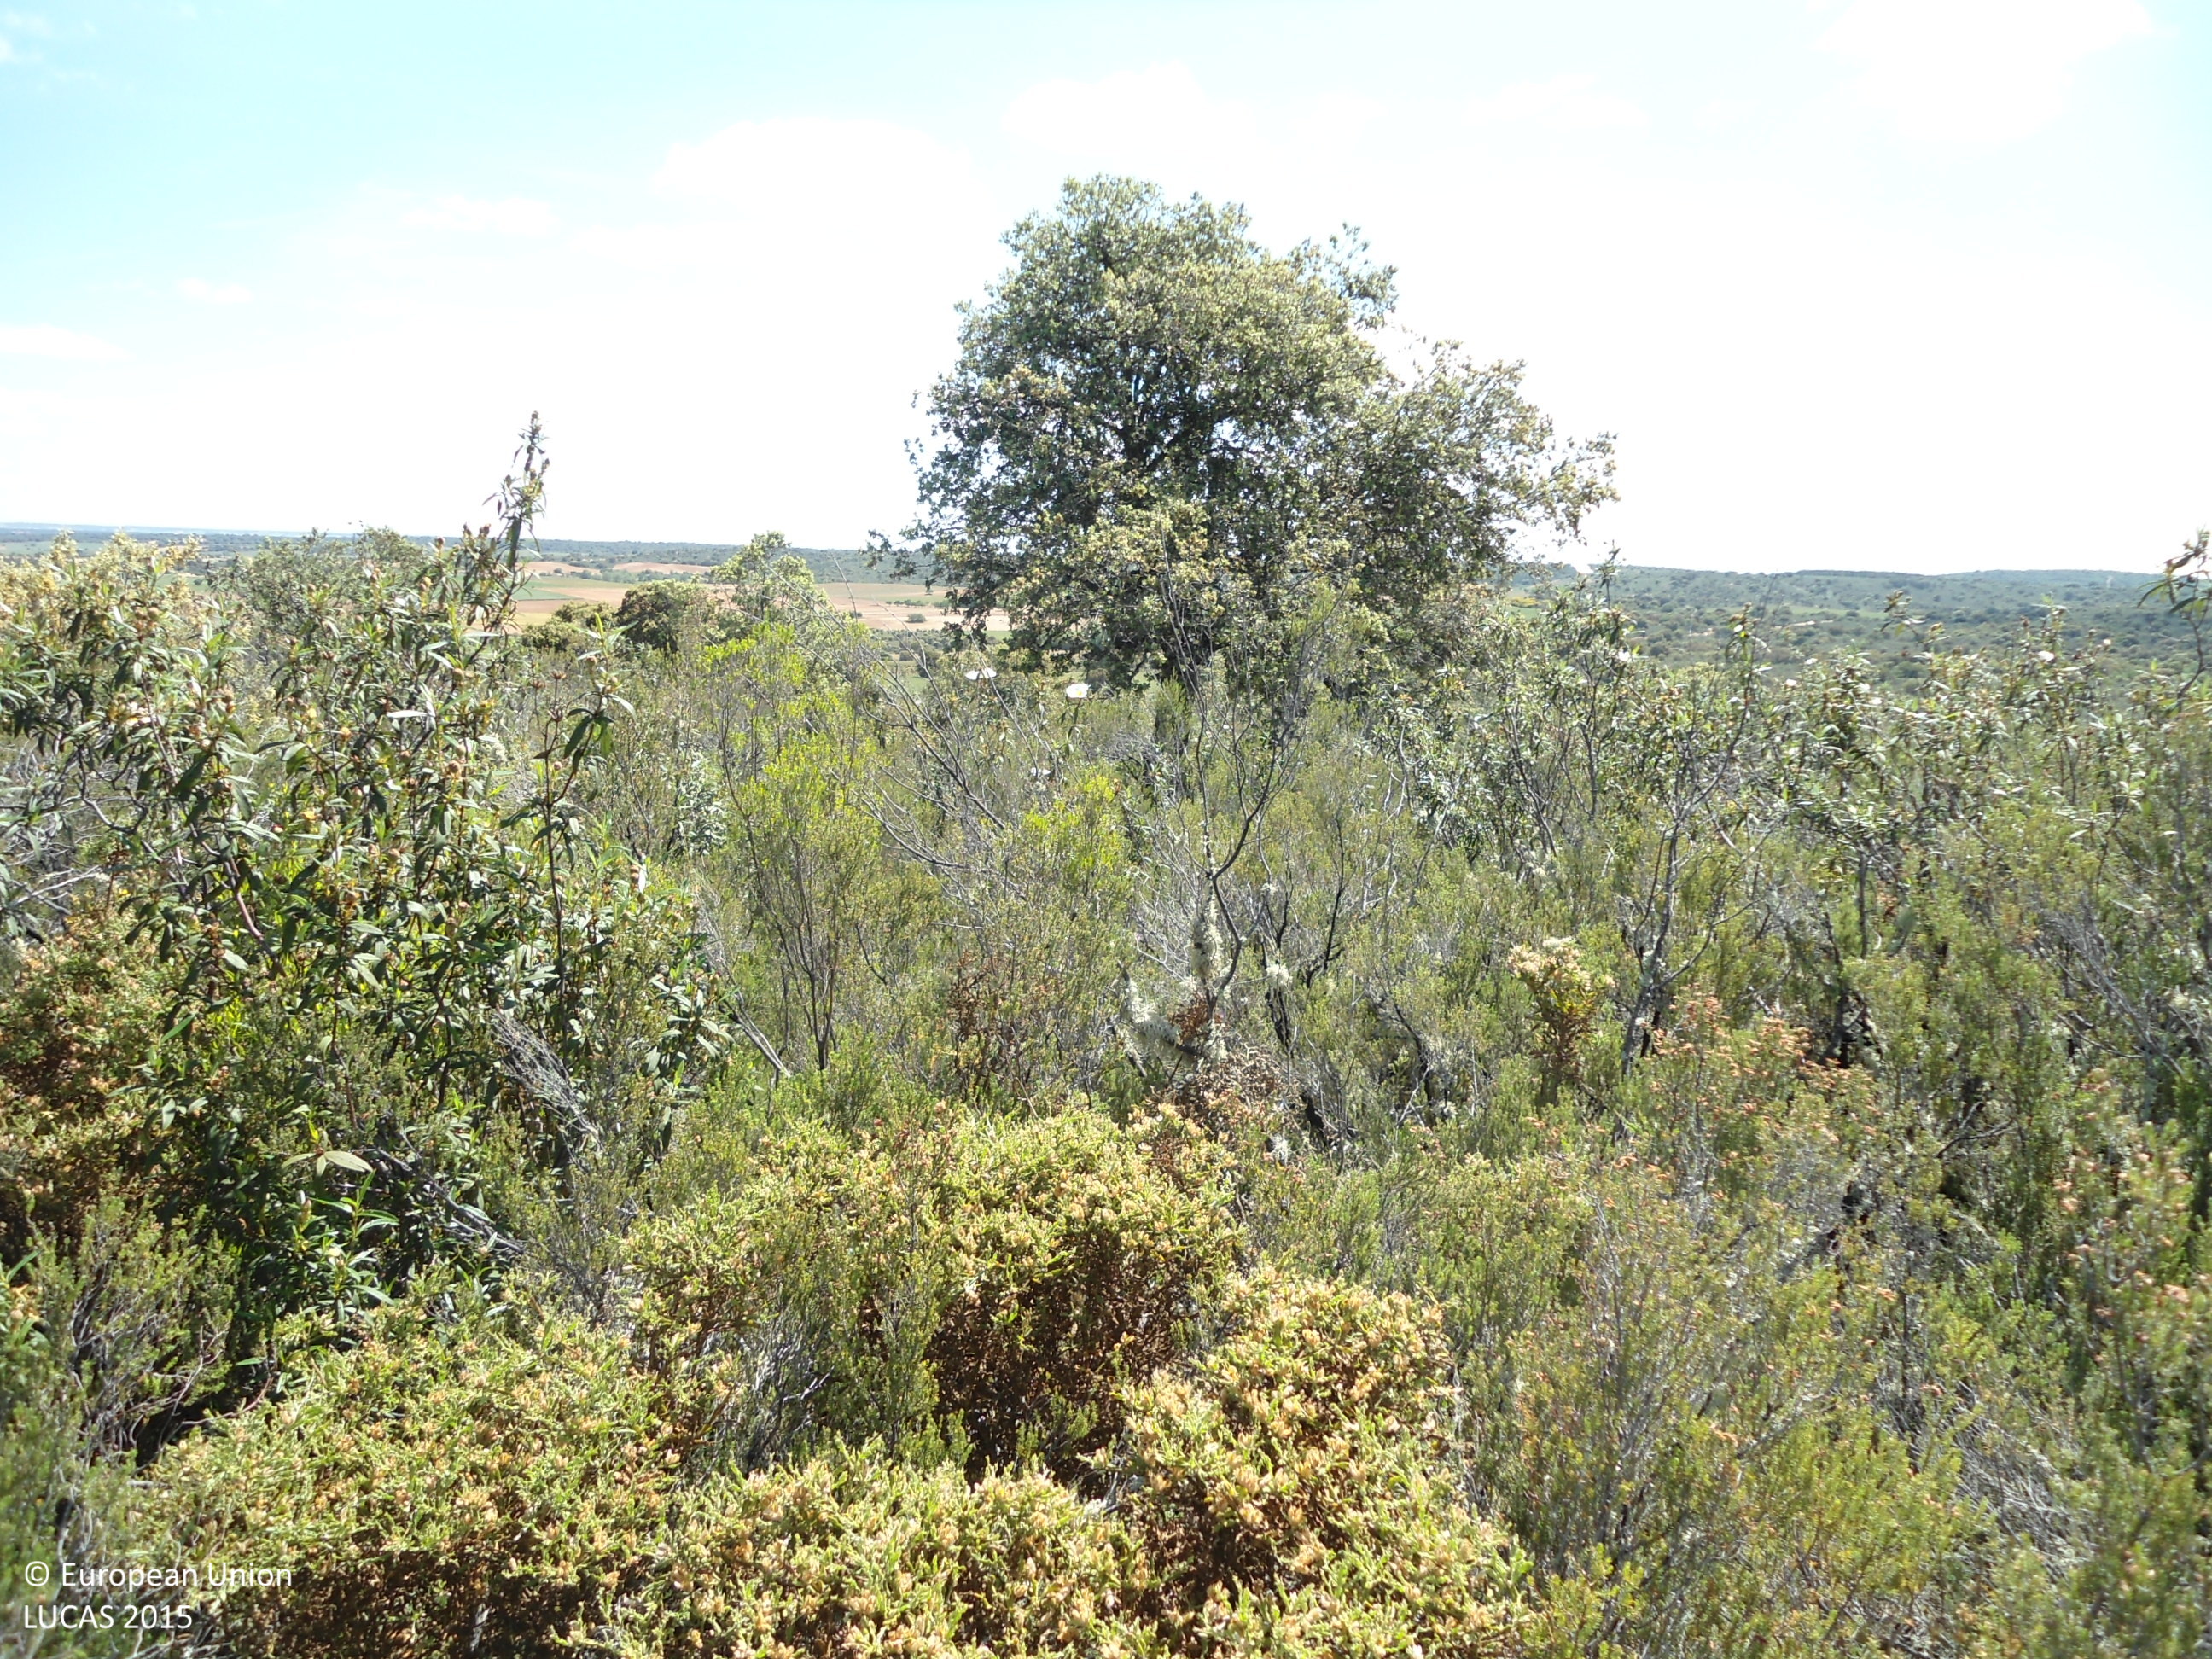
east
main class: Shrubland
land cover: Shrubland with sparse tree cover
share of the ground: > 75 %
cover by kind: shrubs 95 %, broadleaved forest trees 5 %
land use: Semi-natural and natural areas not in use
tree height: < 5 m
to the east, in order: Shrubland with sparse tree cover; Broadleaved woodland; Tracks; Broadleaved woodland; Shrubland with sparse tree cover
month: May
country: ES
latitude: 41.8995
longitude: -5.9223
